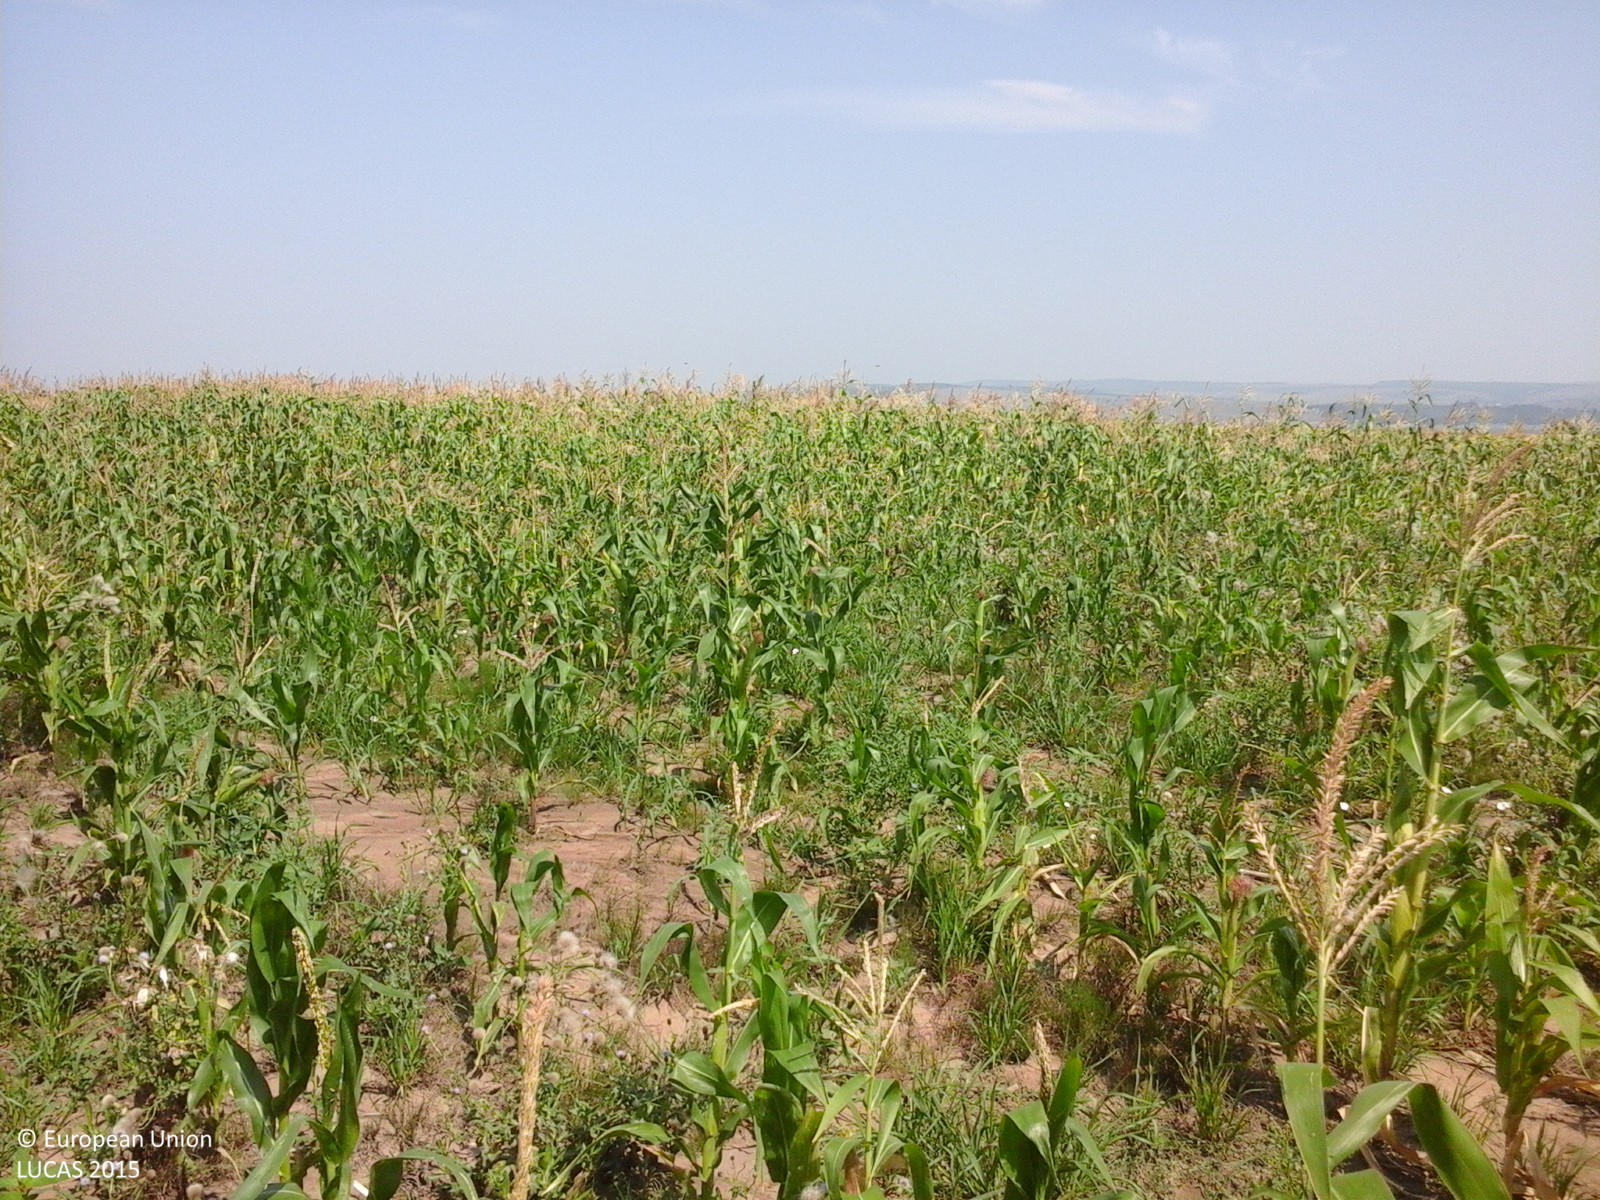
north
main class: Cropland
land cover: Maize
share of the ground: > 75 %
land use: Agriculture (excluding fallow land and kitchen gardens)
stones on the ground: < 10 %
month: August
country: RO
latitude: 46.2135
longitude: 27.0900
